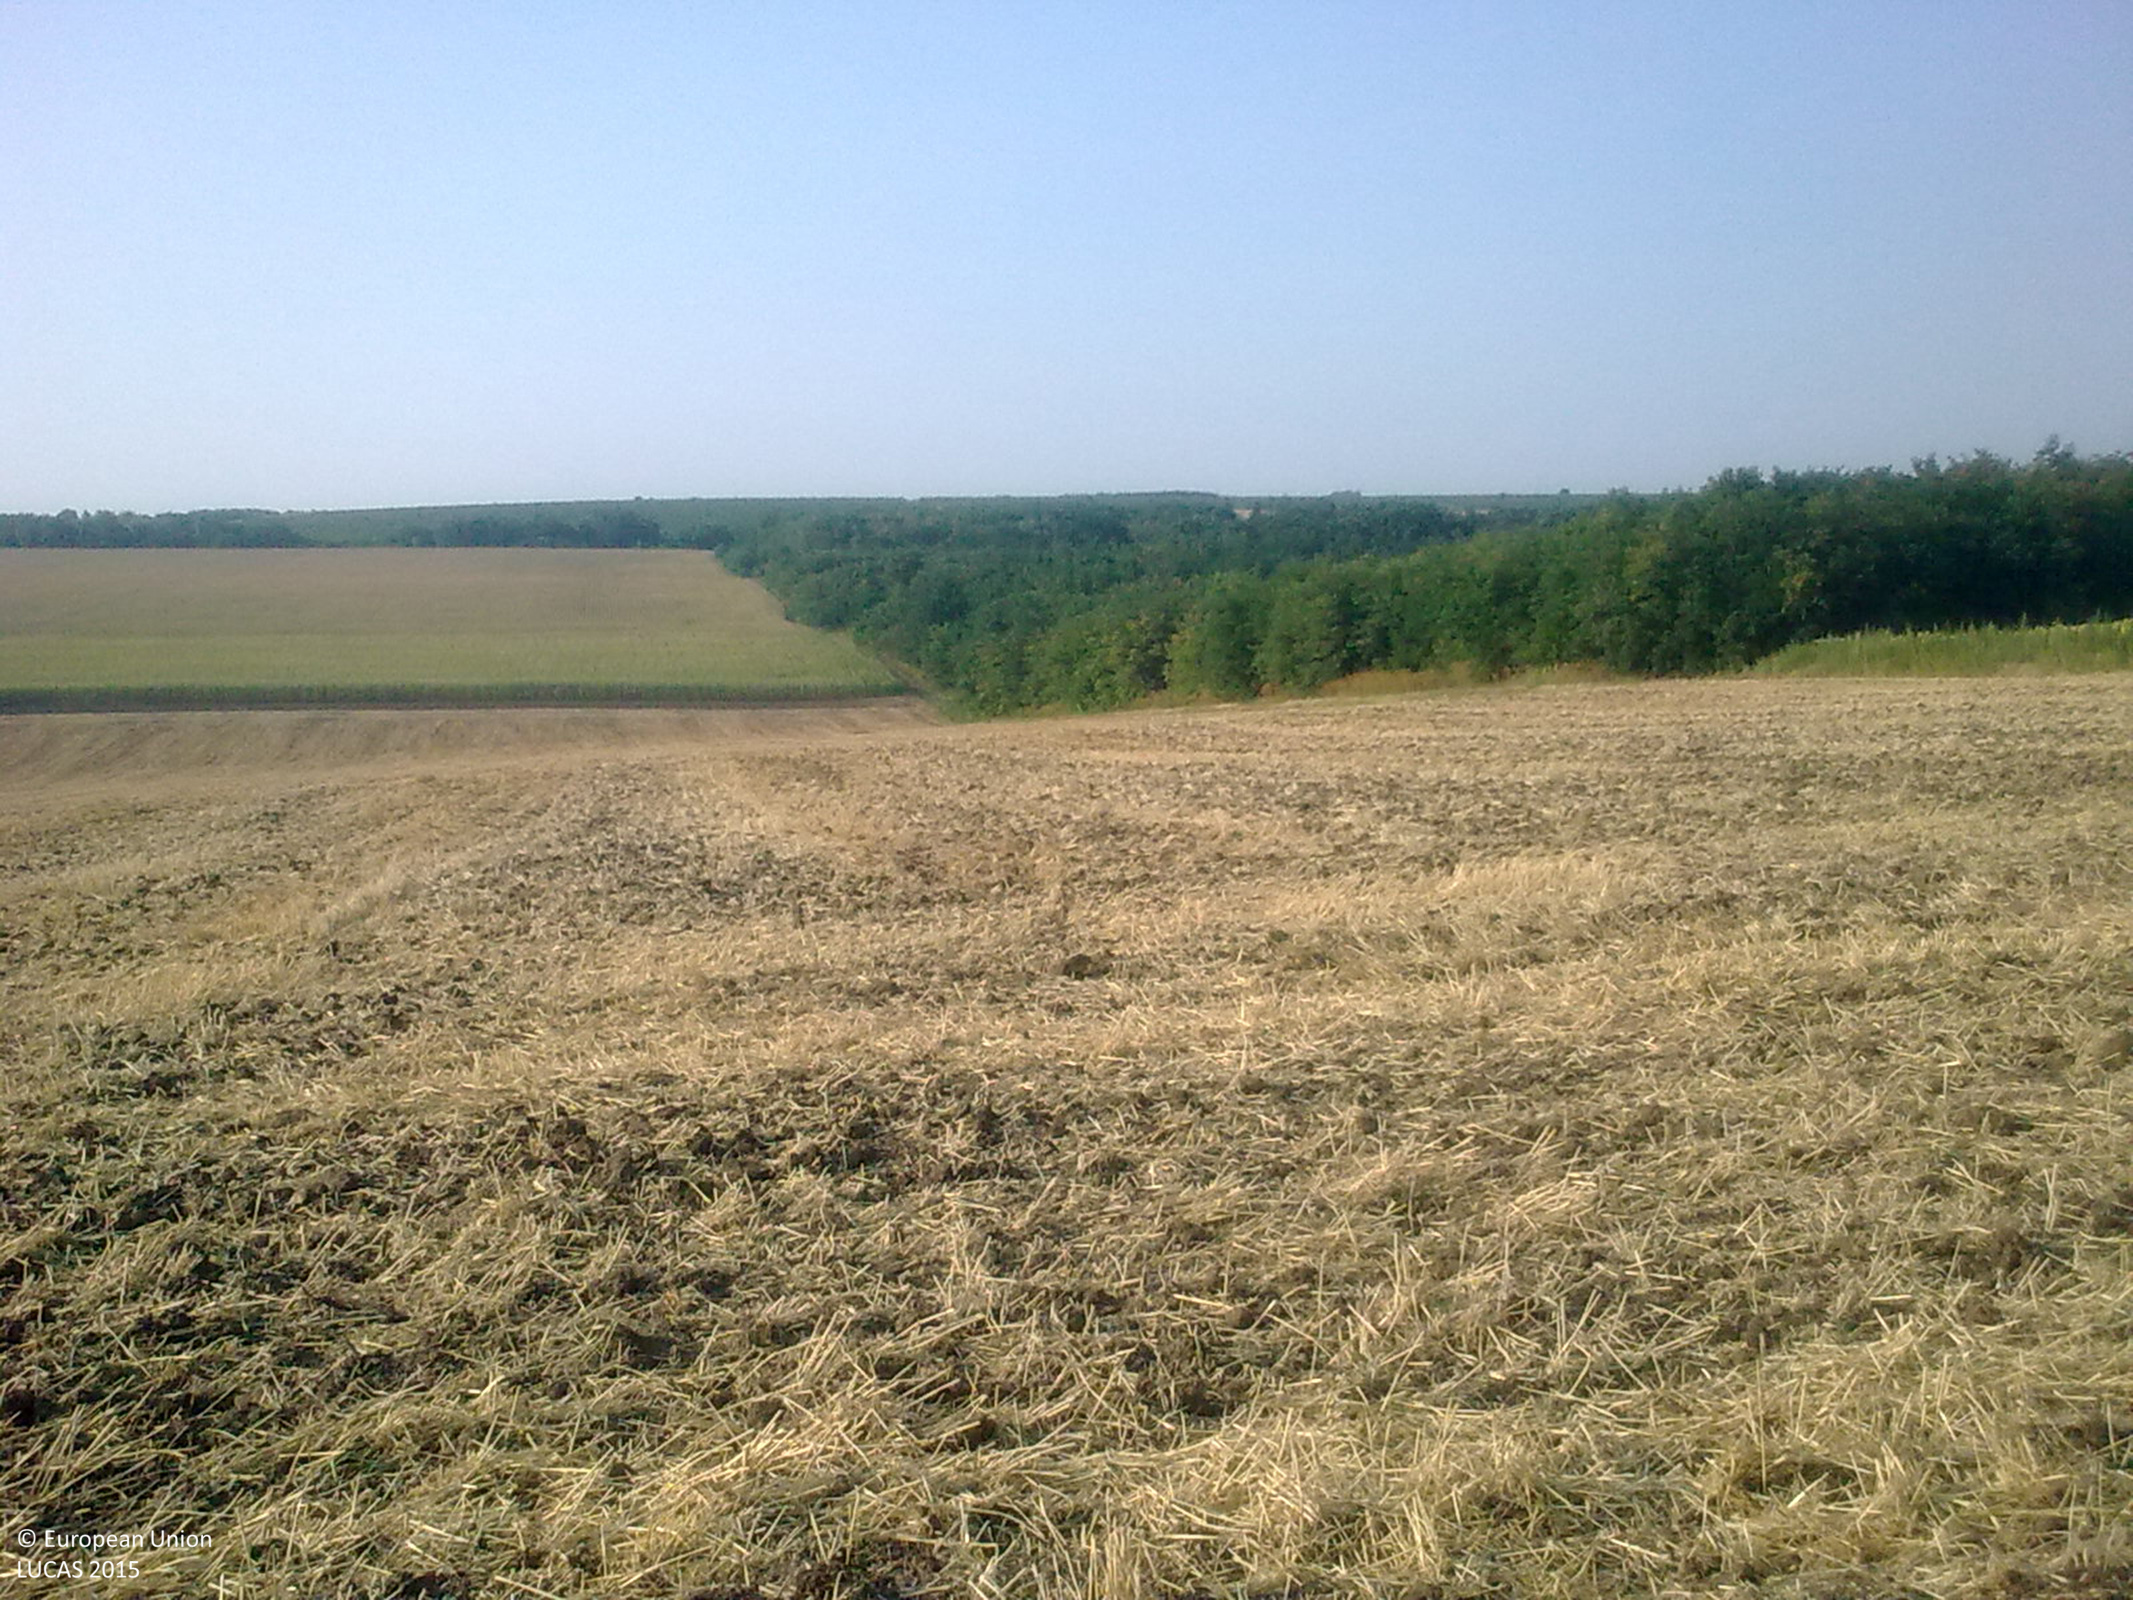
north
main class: Cropland
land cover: Sunflower
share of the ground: > 75 %
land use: Agriculture (excluding fallow land and kitchen gardens)
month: July
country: BG
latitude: 43.4092
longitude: 25.3027
